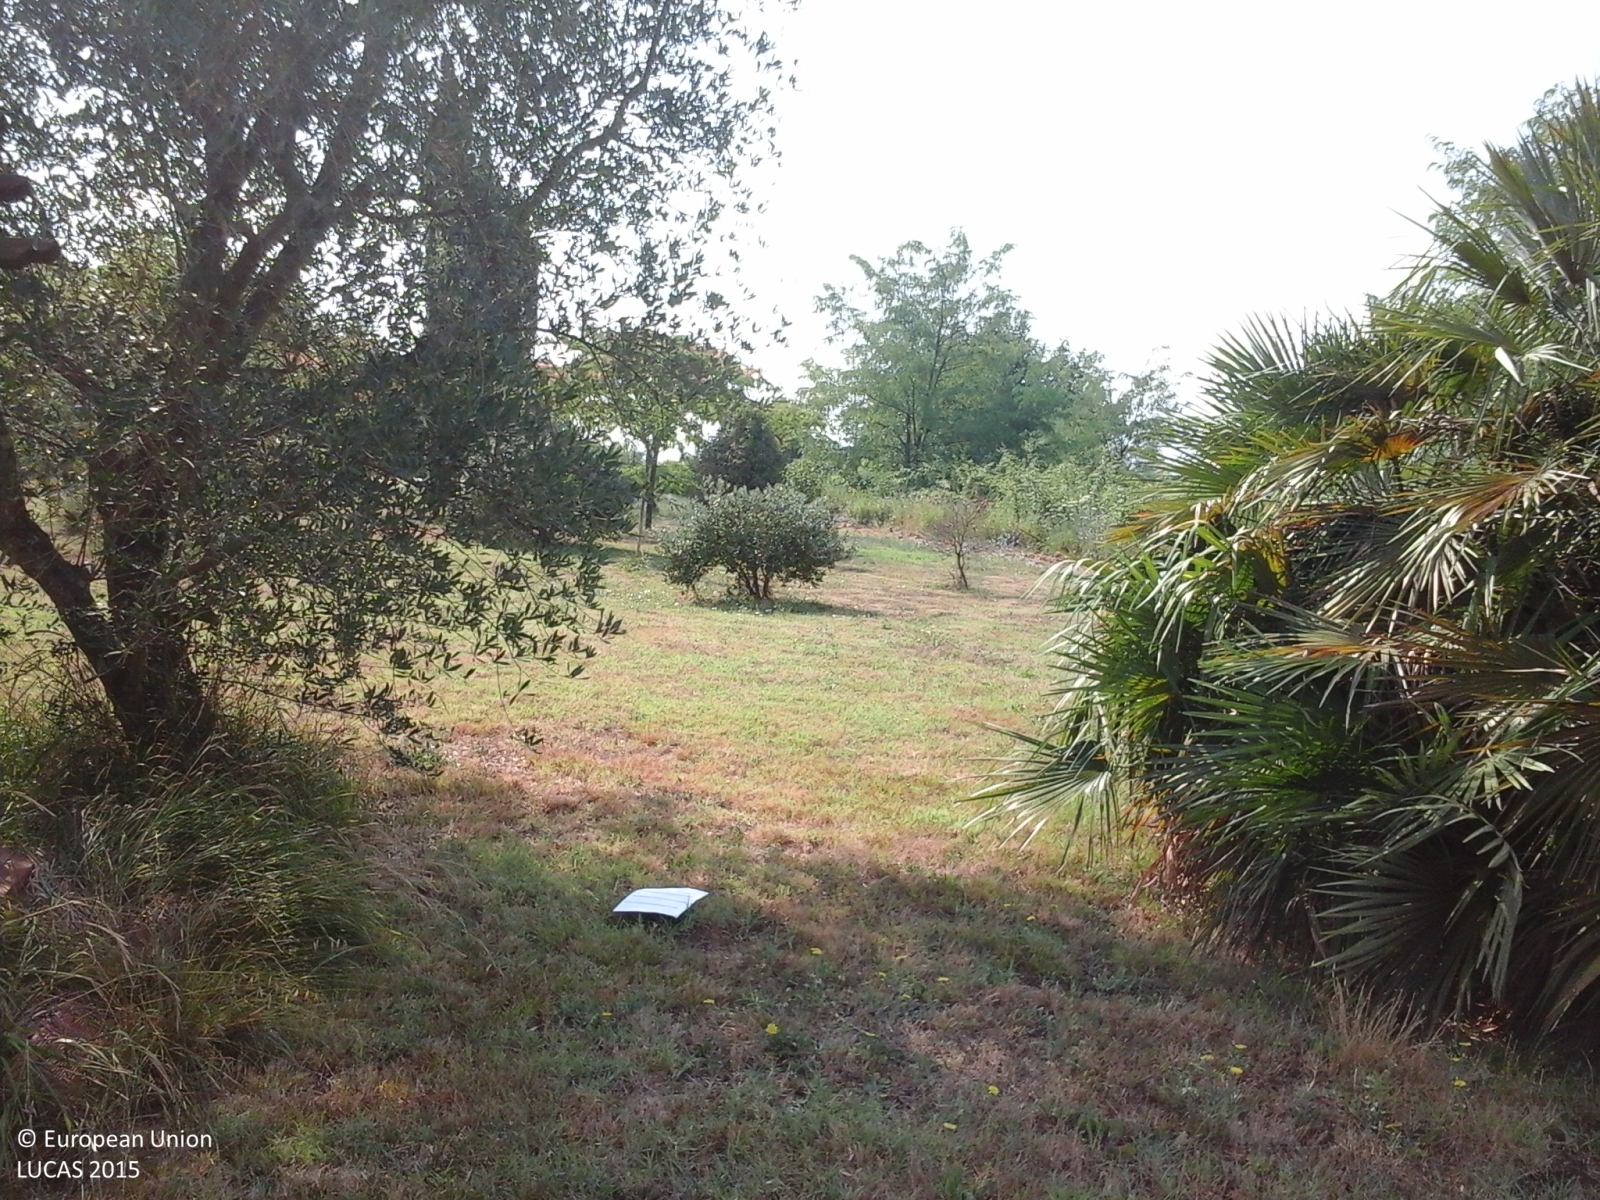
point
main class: Grassland
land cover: Grassland with sparse tree/shrub cover
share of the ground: > 75 %
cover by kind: herbaceous plants 95 %, broadleaved forest trees 5 %
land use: Residential
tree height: < 5 m
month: July
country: IT
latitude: 43.7167
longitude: 10.7056
